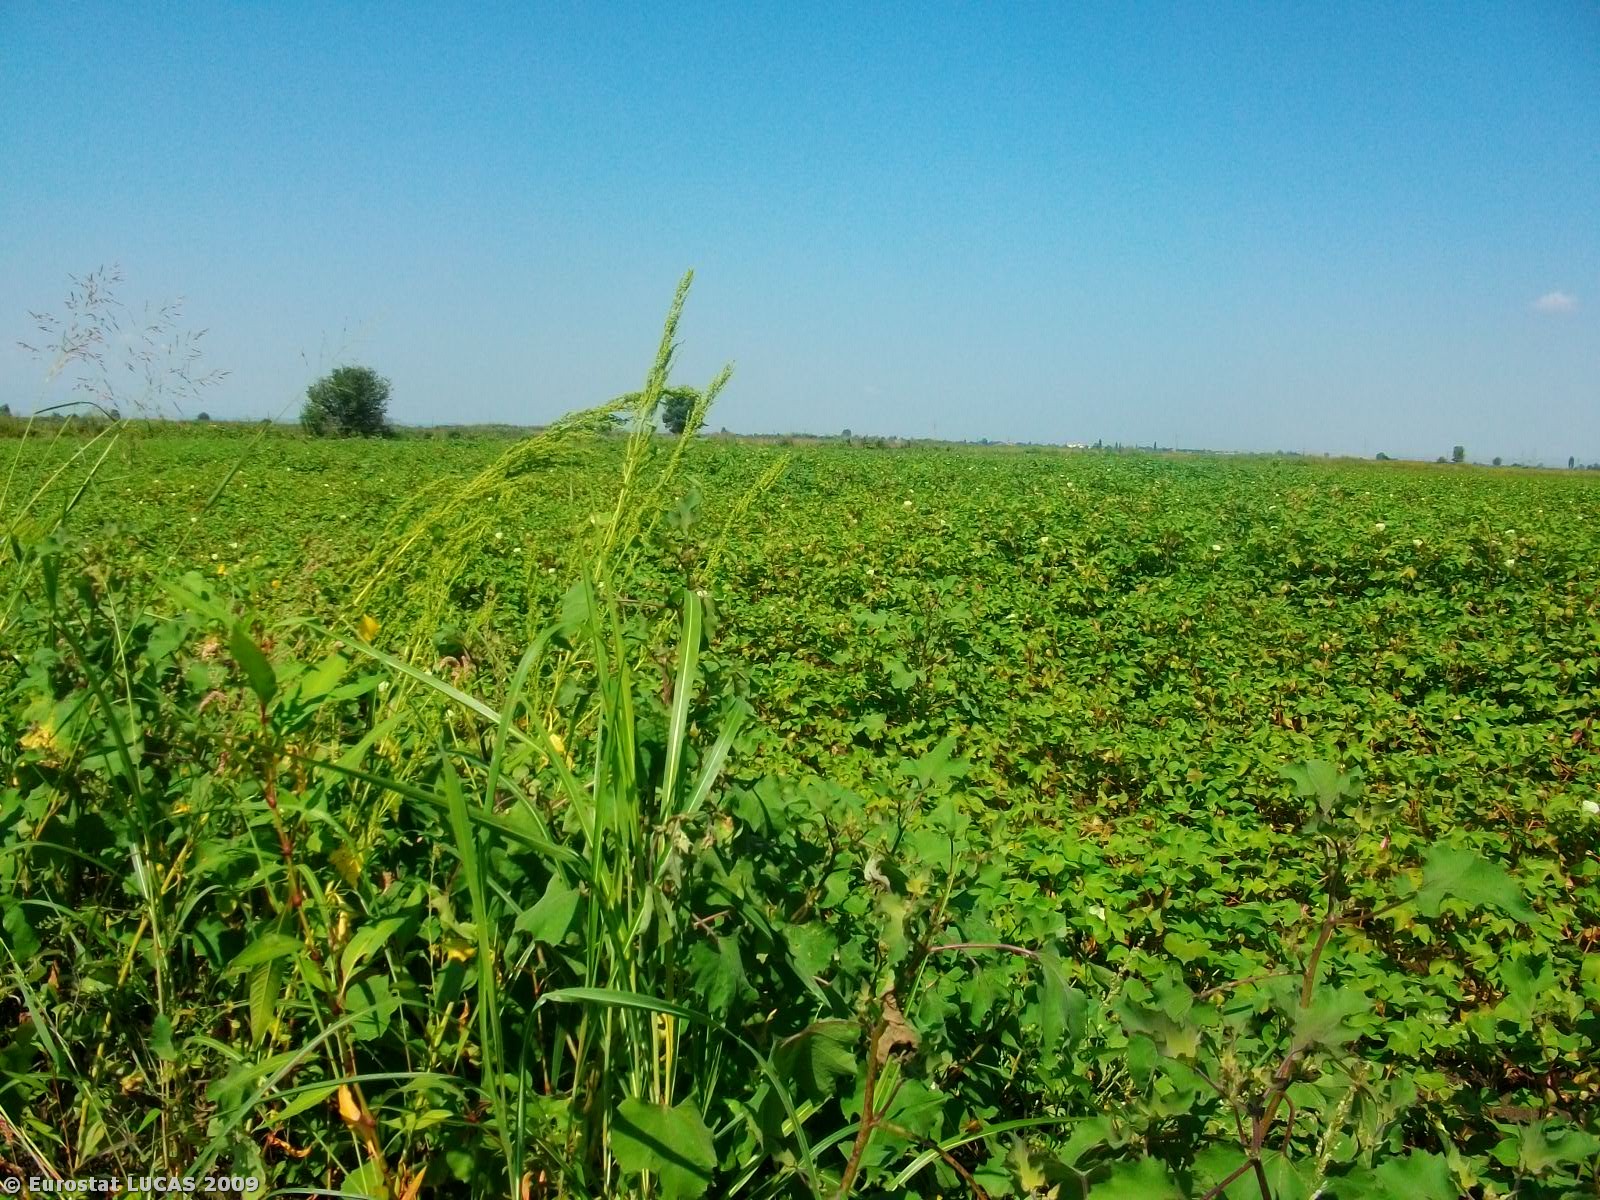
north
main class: Cropland
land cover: Cotton
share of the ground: > 75 %
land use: Agriculture (excluding fallow land and kitchen gardens)
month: August
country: GR
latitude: 40.6404
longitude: 22.5964
